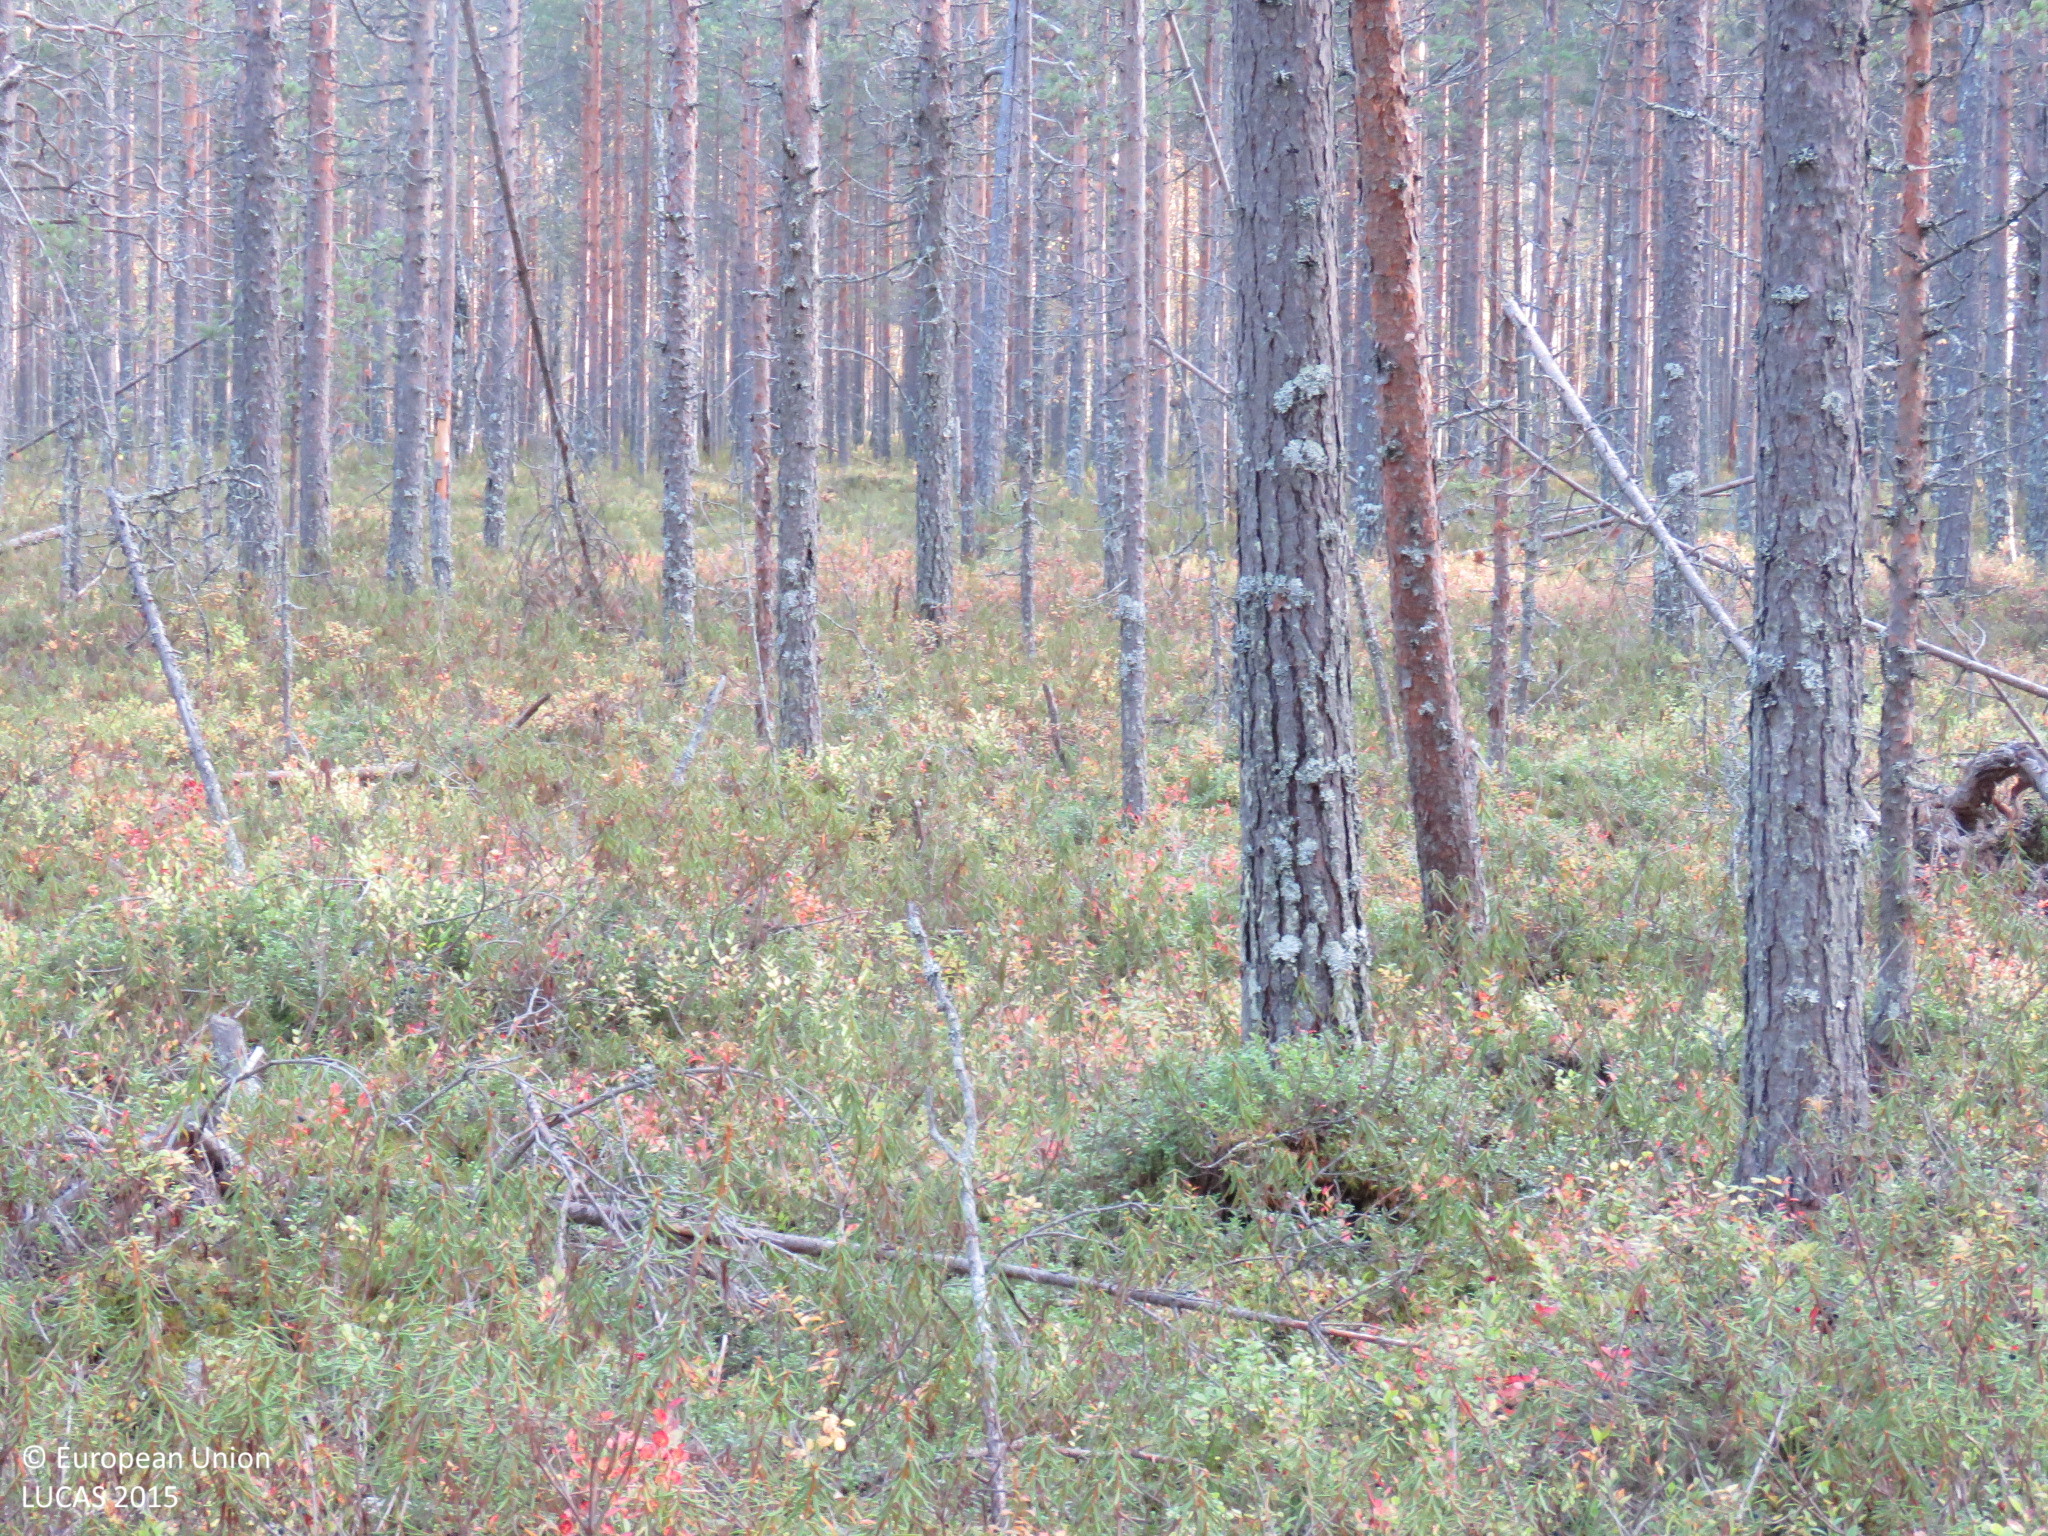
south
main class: Woodland
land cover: Pine dominated coniferous woodland
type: boreal forest
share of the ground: 50 - 75 %
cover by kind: coniferous forest trees 70 %, shrubs 20 %, lichens and mosses 10 %
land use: Forestry
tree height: > 5 m
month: September
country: FI
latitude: 65.1096
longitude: 26.9626
